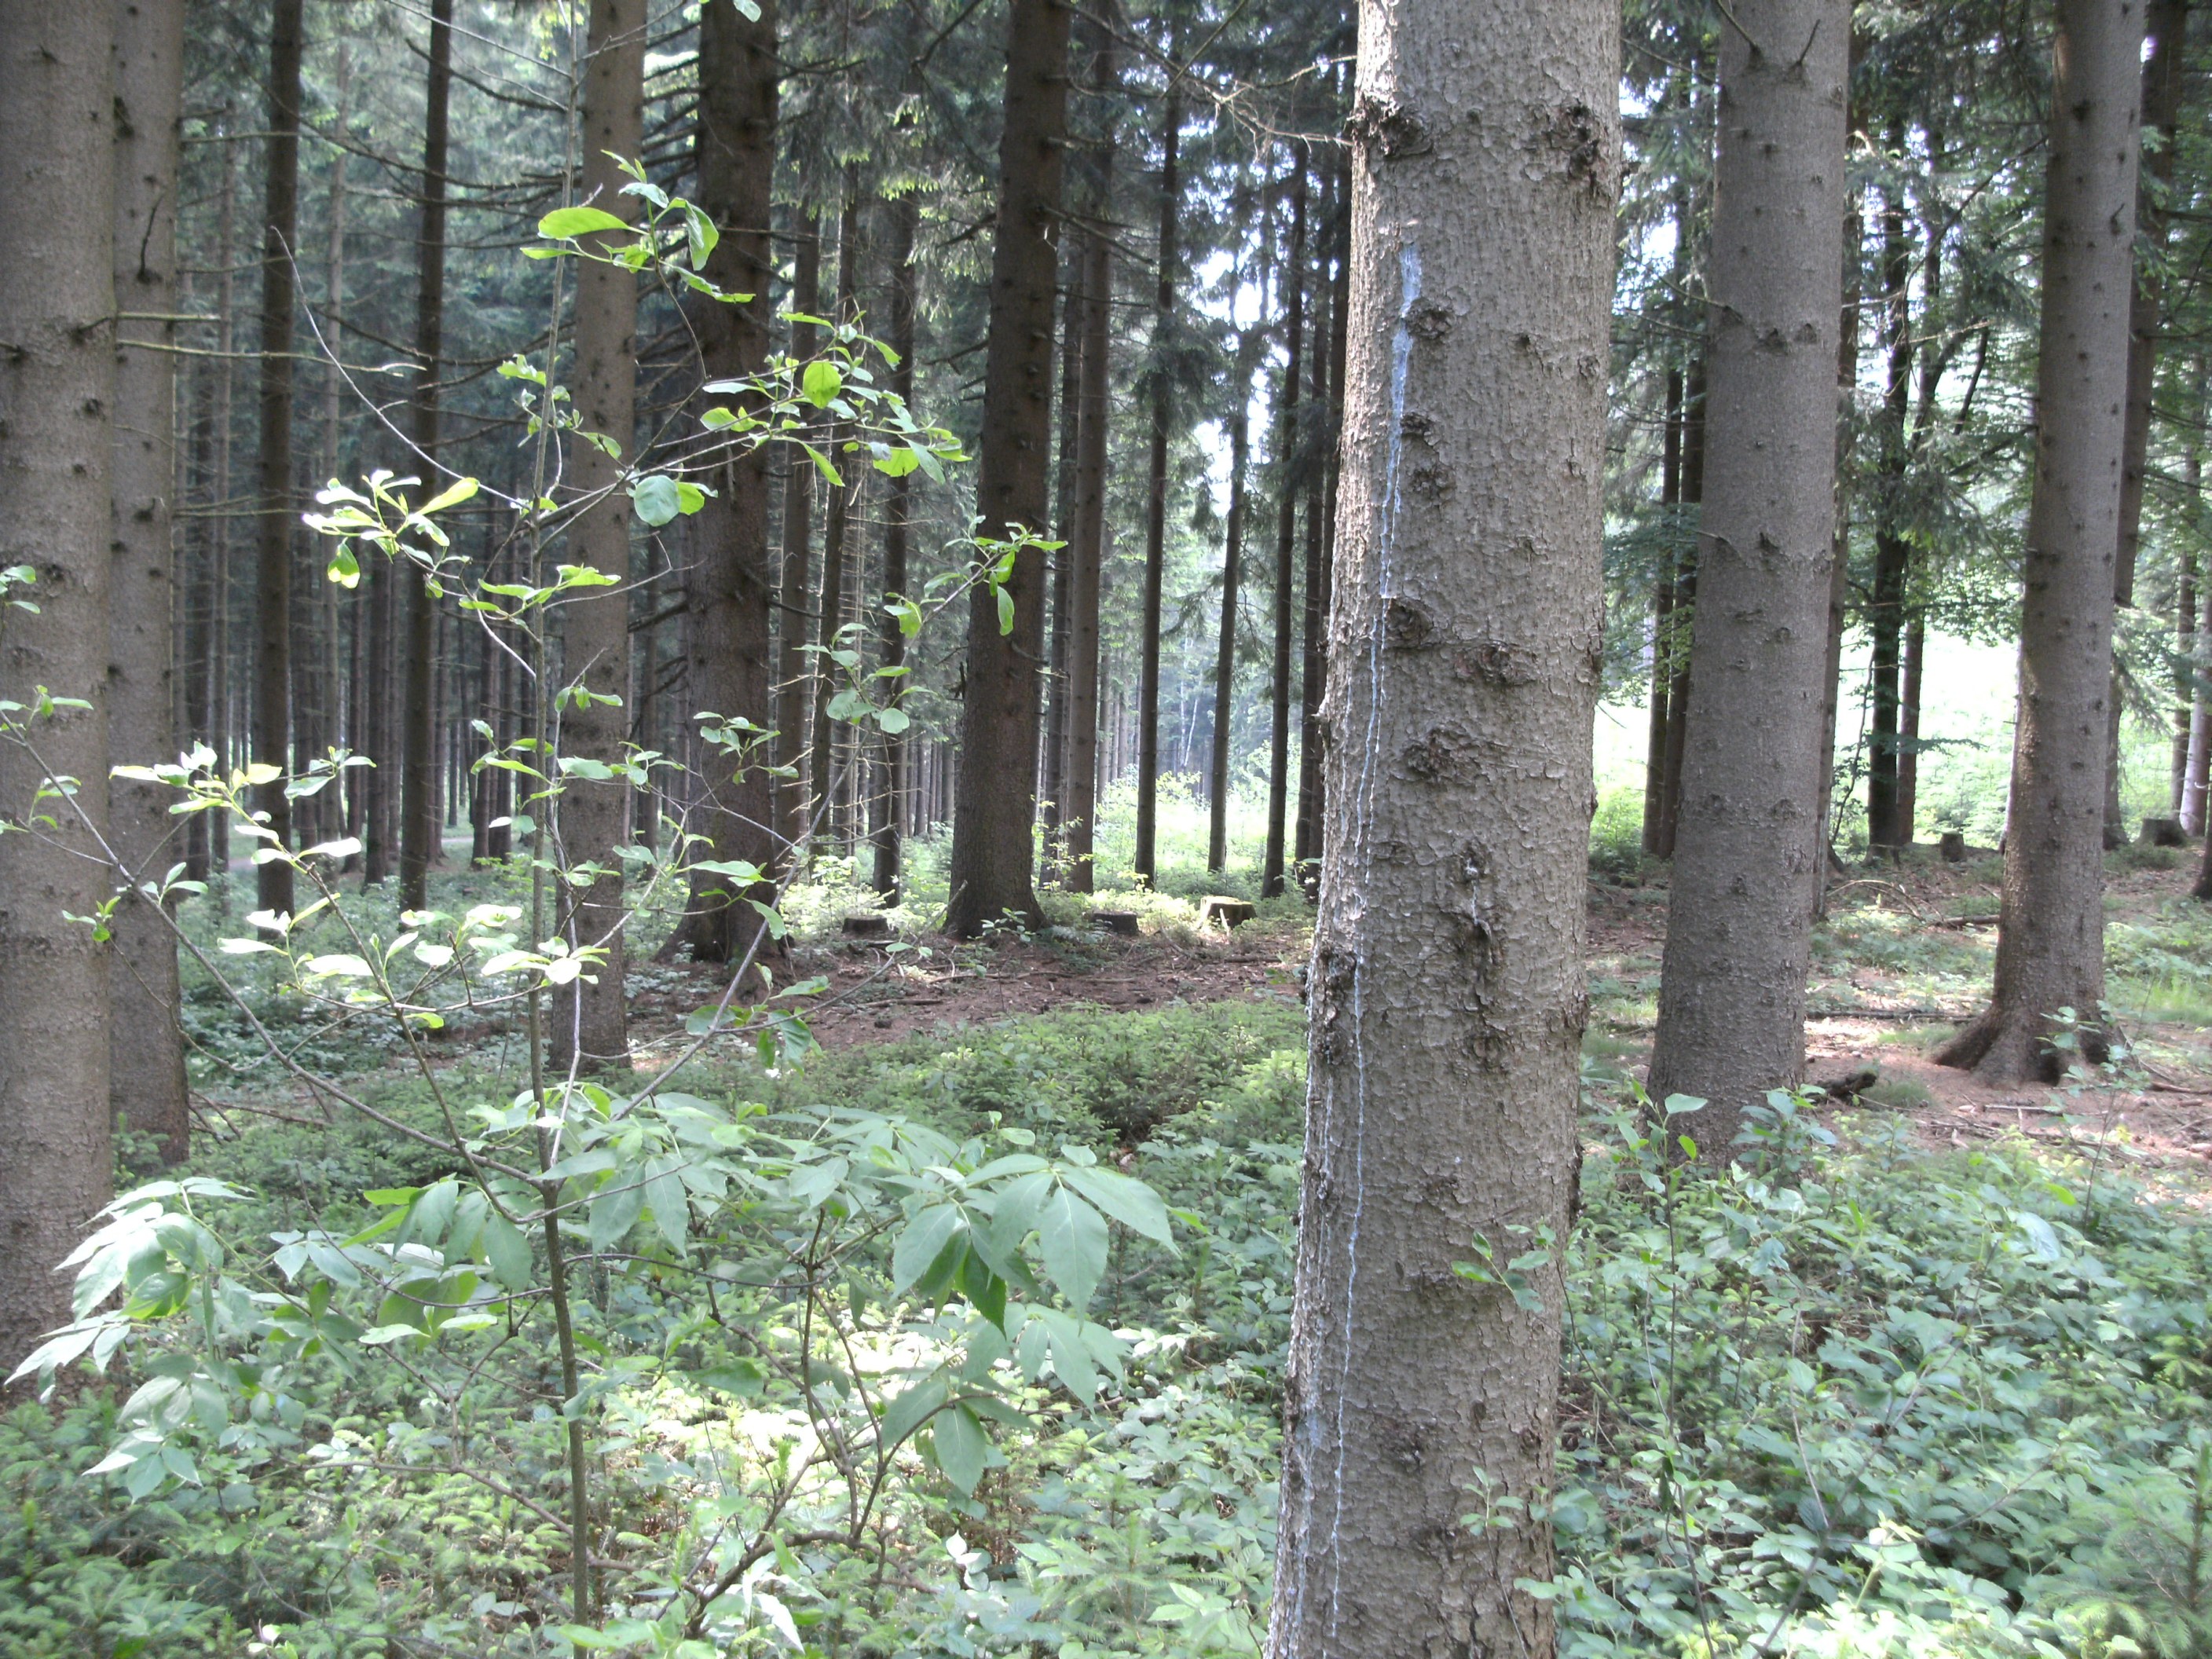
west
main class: Woodland
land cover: Spruce dominated coniferous woodland
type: alpine coniferous forest
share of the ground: > 75 %
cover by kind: coniferous forest trees 80 %, shrubs 15 %, herbaceous plants 5 %
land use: Forestry
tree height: > 5 m
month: June
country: AT
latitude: 48.5046
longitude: 14.1825
